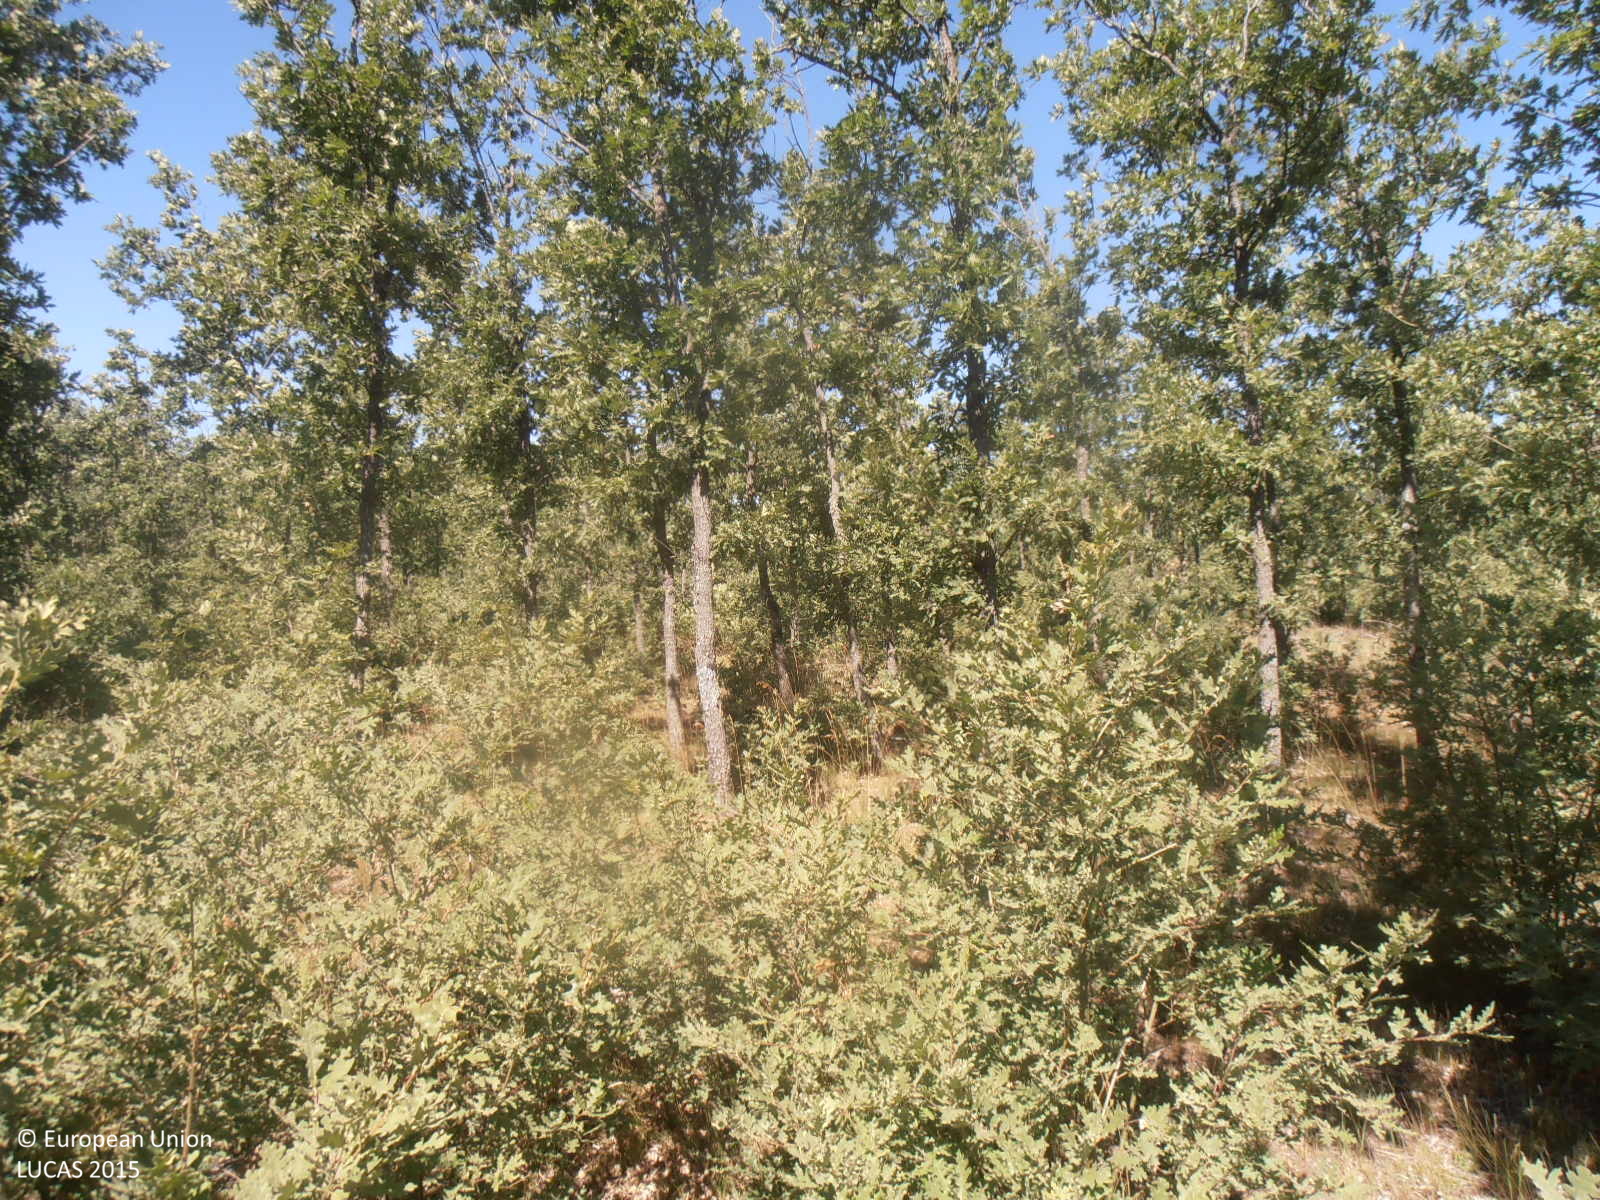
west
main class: Woodland
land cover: Broadleaved woodland
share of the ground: > 75 %
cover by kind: broadleaved forest trees 80 %, herbaceous plants 15 %, shrubs 5 %
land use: Forestry
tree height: < 5 m
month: June
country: ES
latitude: 41.7227
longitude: -1.9687
